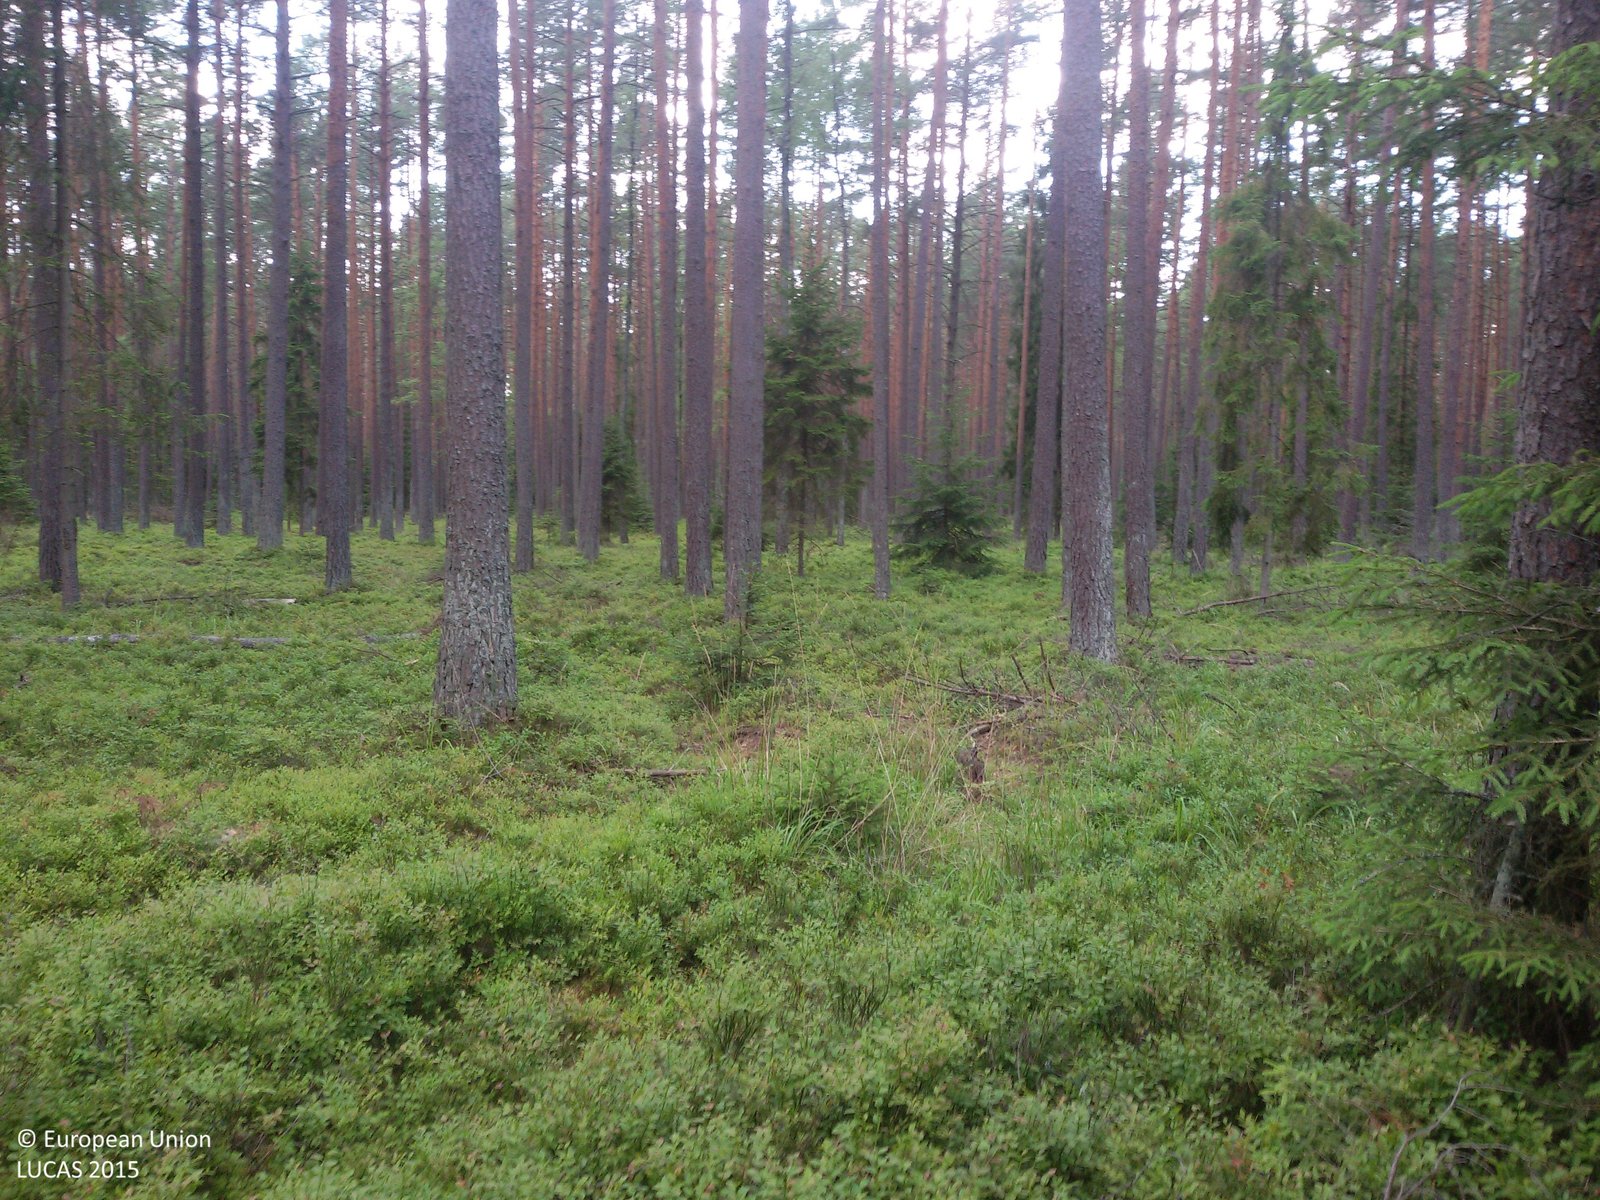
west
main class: Woodland
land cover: Pine dominated coniferous woodland
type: hemiboreal forest and nemoral coniferous forest and mixed broadleaved-coniferous forest
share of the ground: > 75 %
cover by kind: coniferous forest trees 85 %, shrubs 15 %
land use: Forestry
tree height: > 5 m
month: July
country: PL
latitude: 53.6100
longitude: 21.5529
